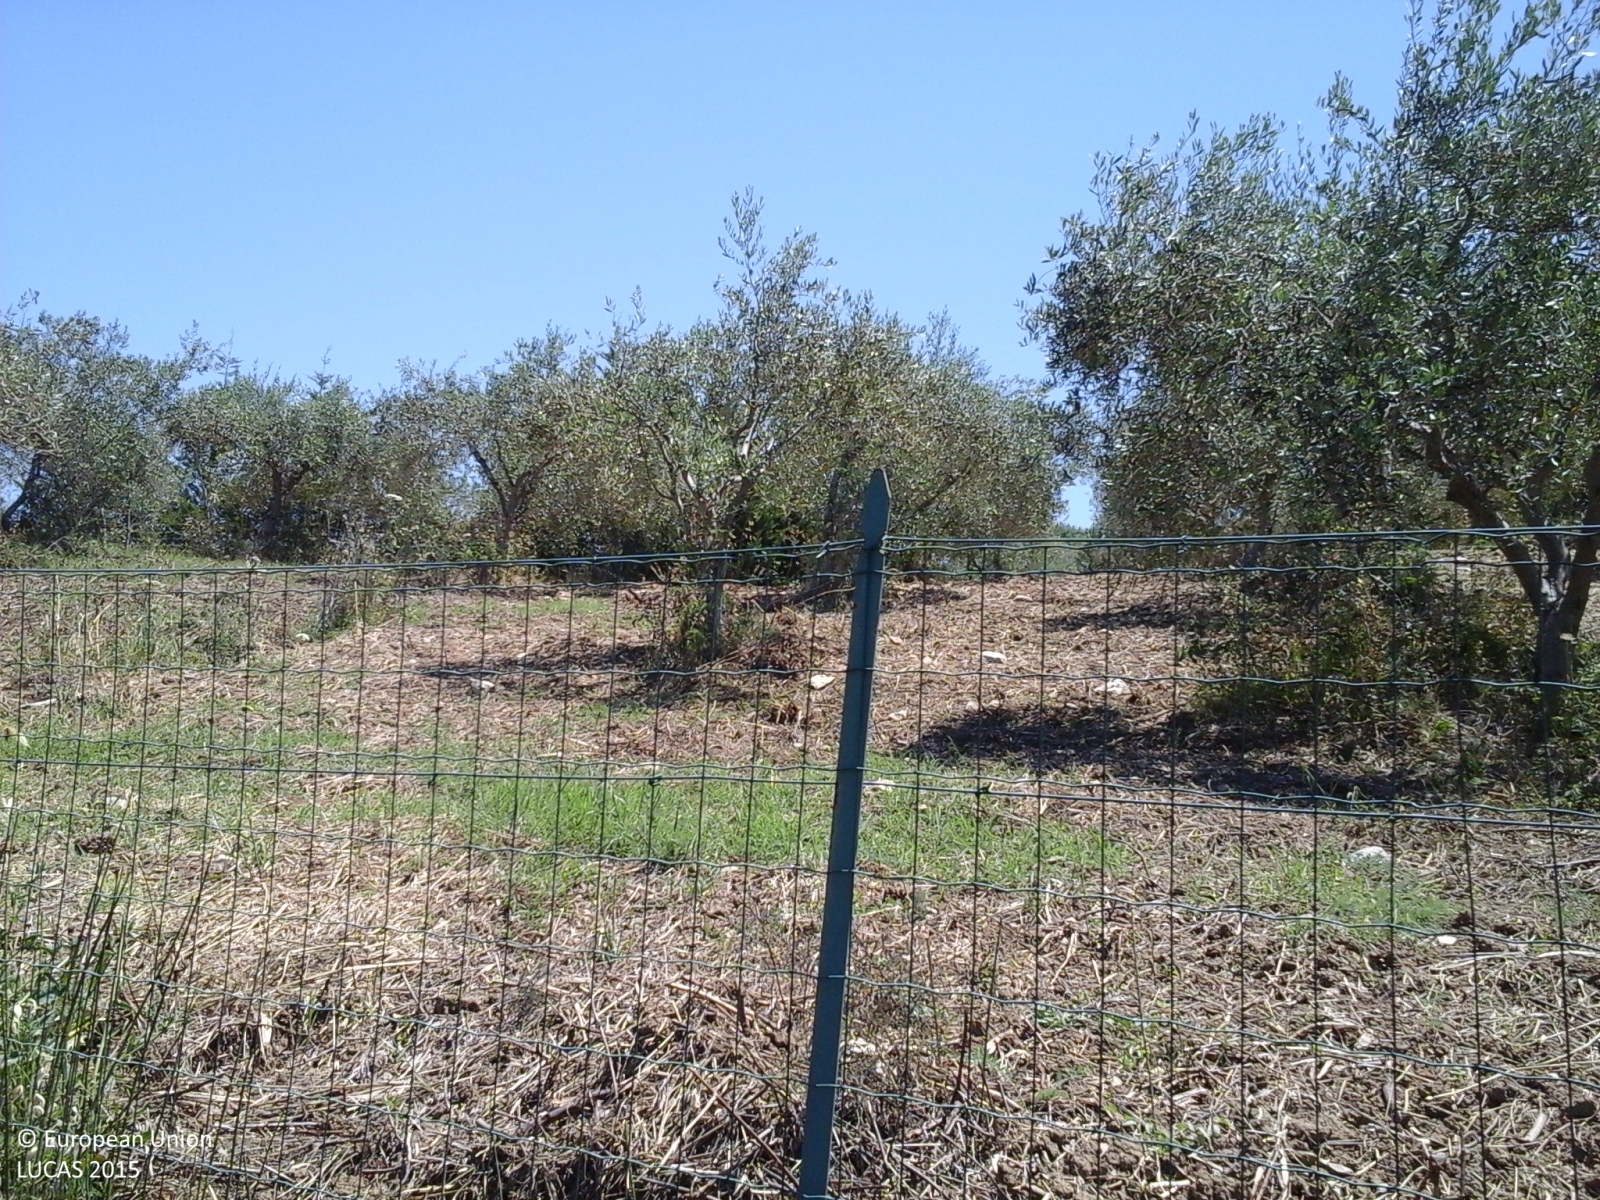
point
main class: Cropland
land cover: Olive groves
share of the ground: 50 - 75 %
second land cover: Spontaneously vegetated surfaces
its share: > 75 %
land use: Agriculture (excluding fallow land and kitchen gardens)
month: June
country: IT
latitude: 37.9500
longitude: 13.6499
